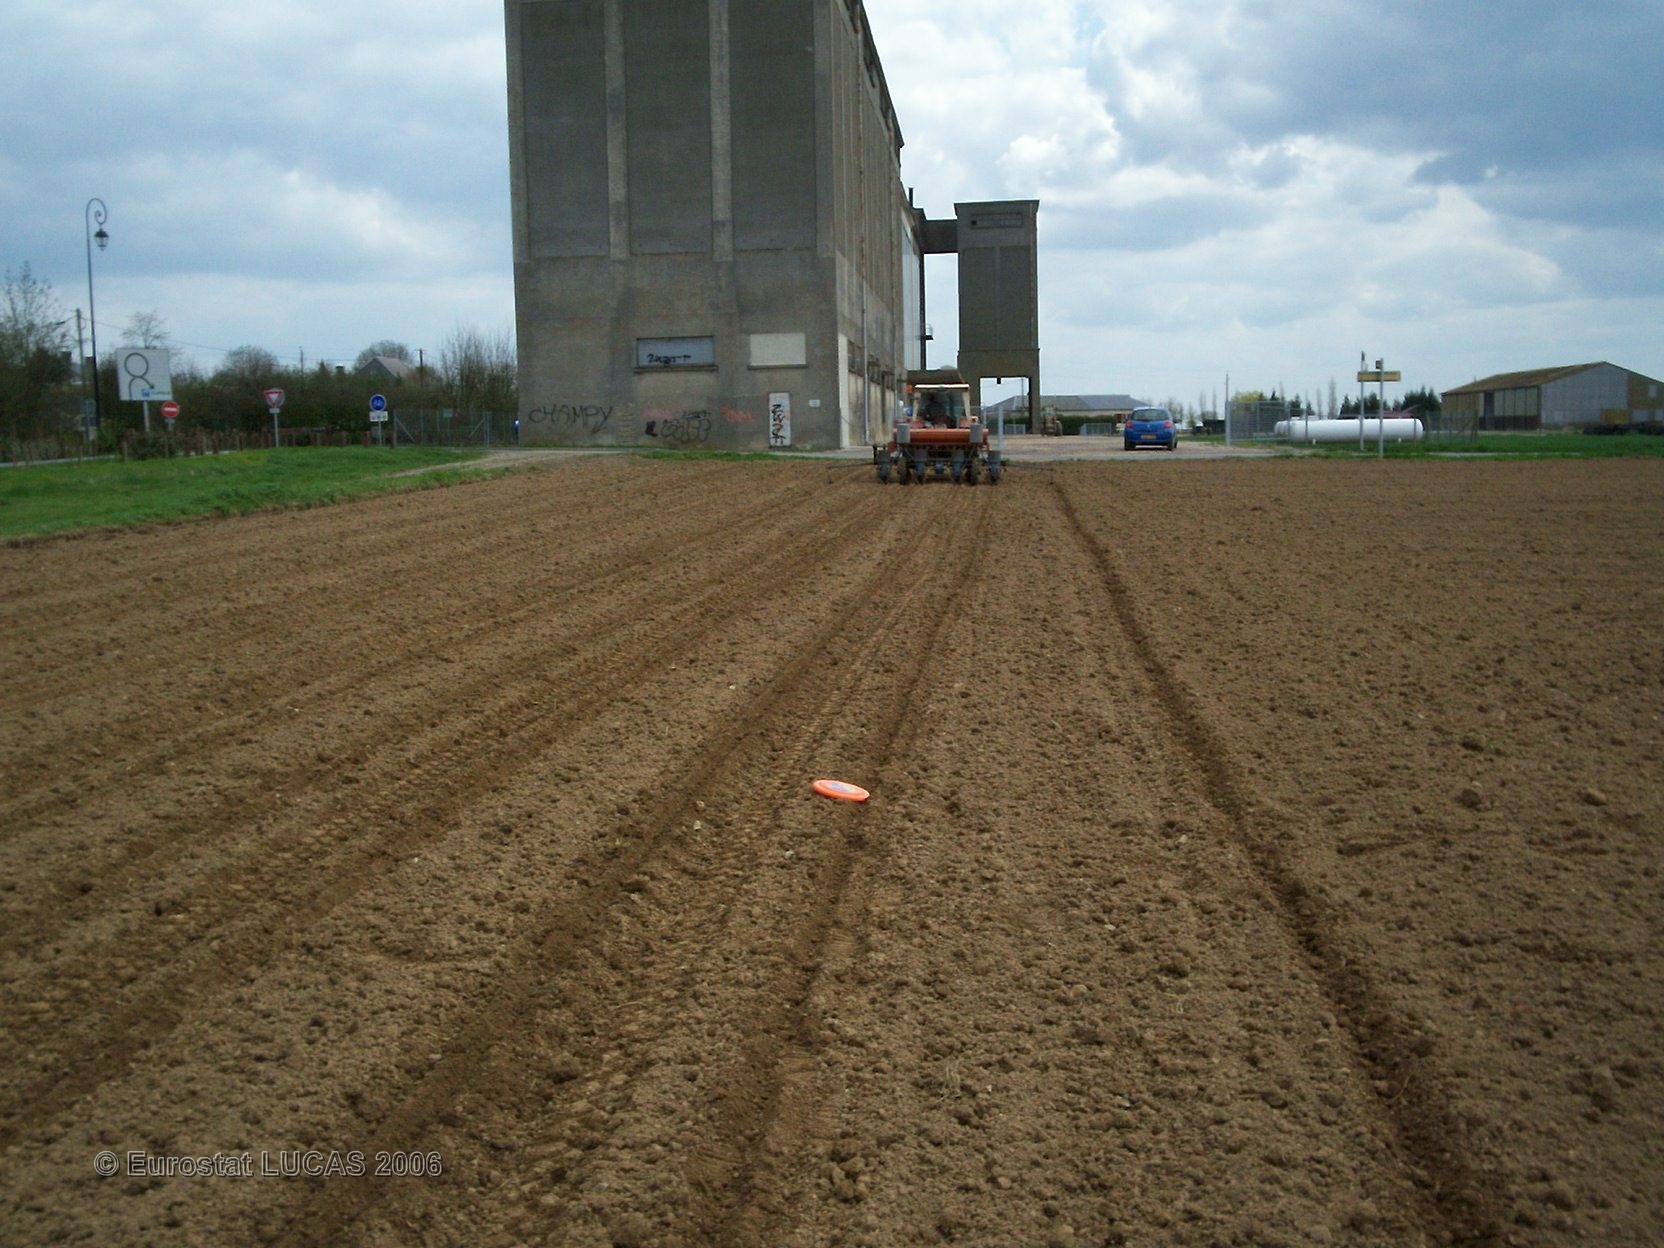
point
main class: Cropland
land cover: Maize
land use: Agriculture (excluding fallow land and kitchen gardens)
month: April
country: FR
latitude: 49.0887
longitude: 1.0369
